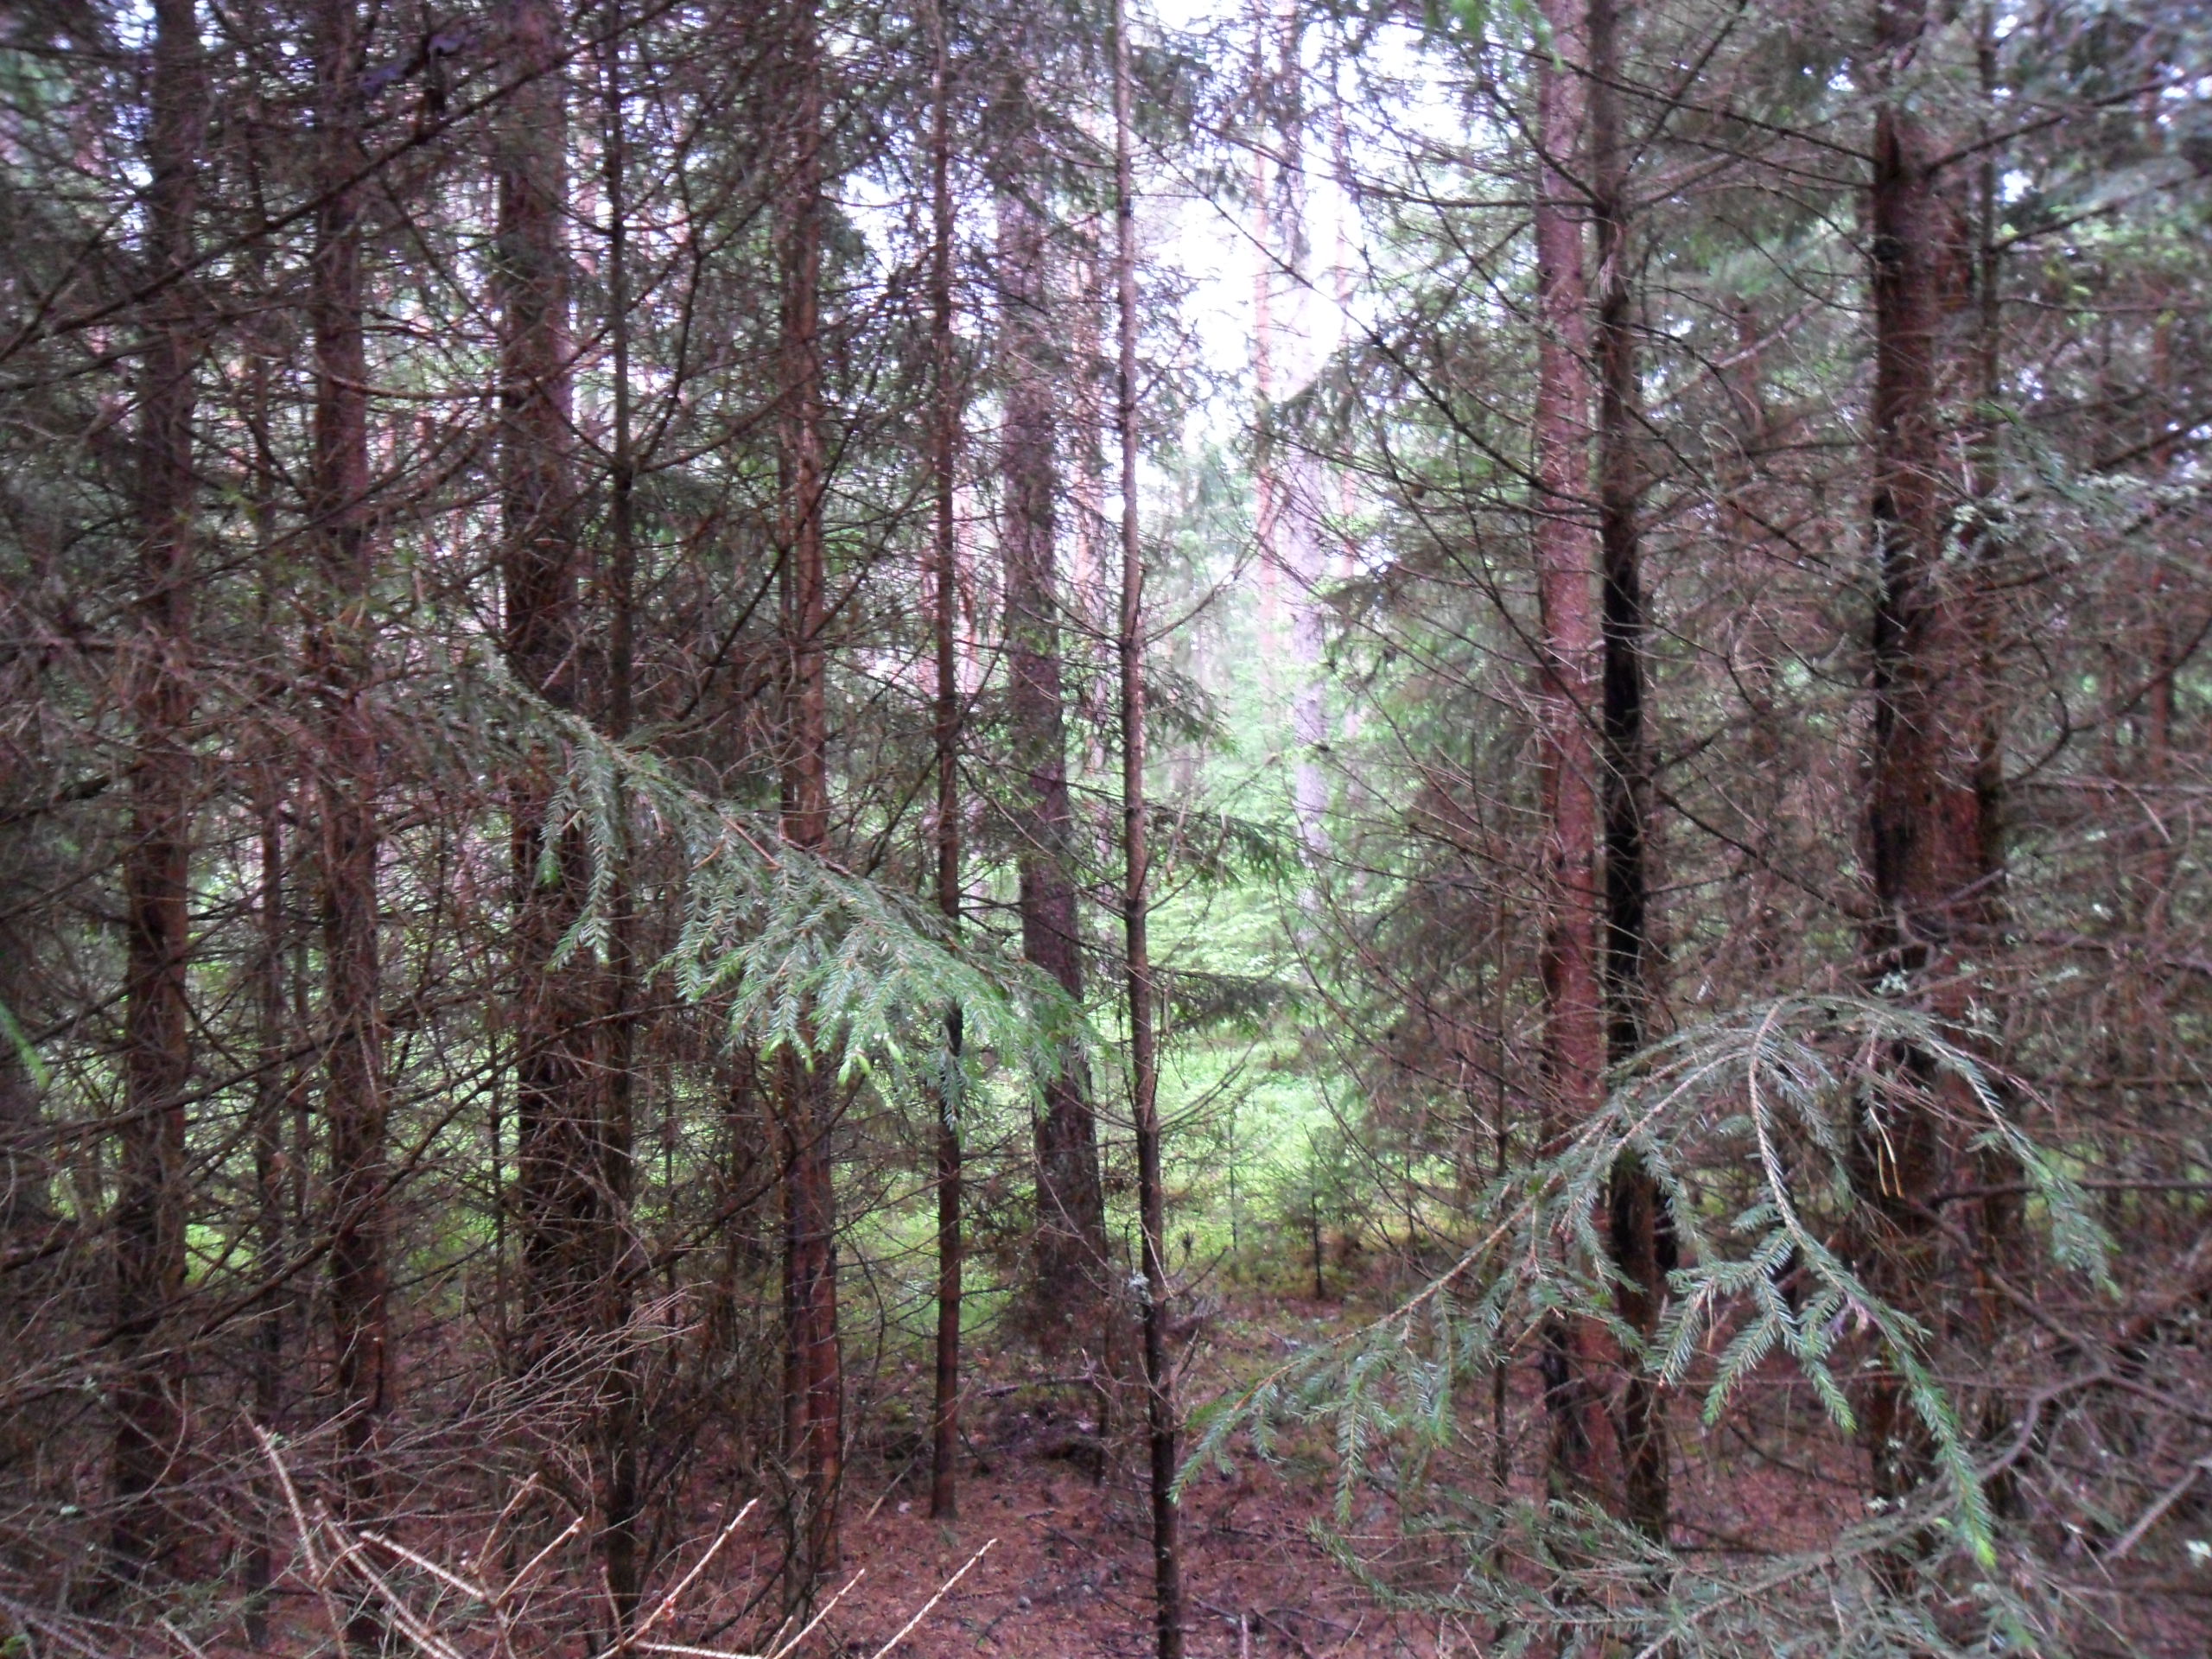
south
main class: Woodland
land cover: Spruce dominated coniferous woodland
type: hemiboreal forest and nemoral coniferous forest and mixed broadleaved-coniferous forest
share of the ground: > 75 %
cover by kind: coniferous forest trees 80 %, herbaceous plants 10 %, lichens and mosses 10 %
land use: Forestry
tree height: > 5 m
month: June
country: LV
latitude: 57.3814
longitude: 22.0725
